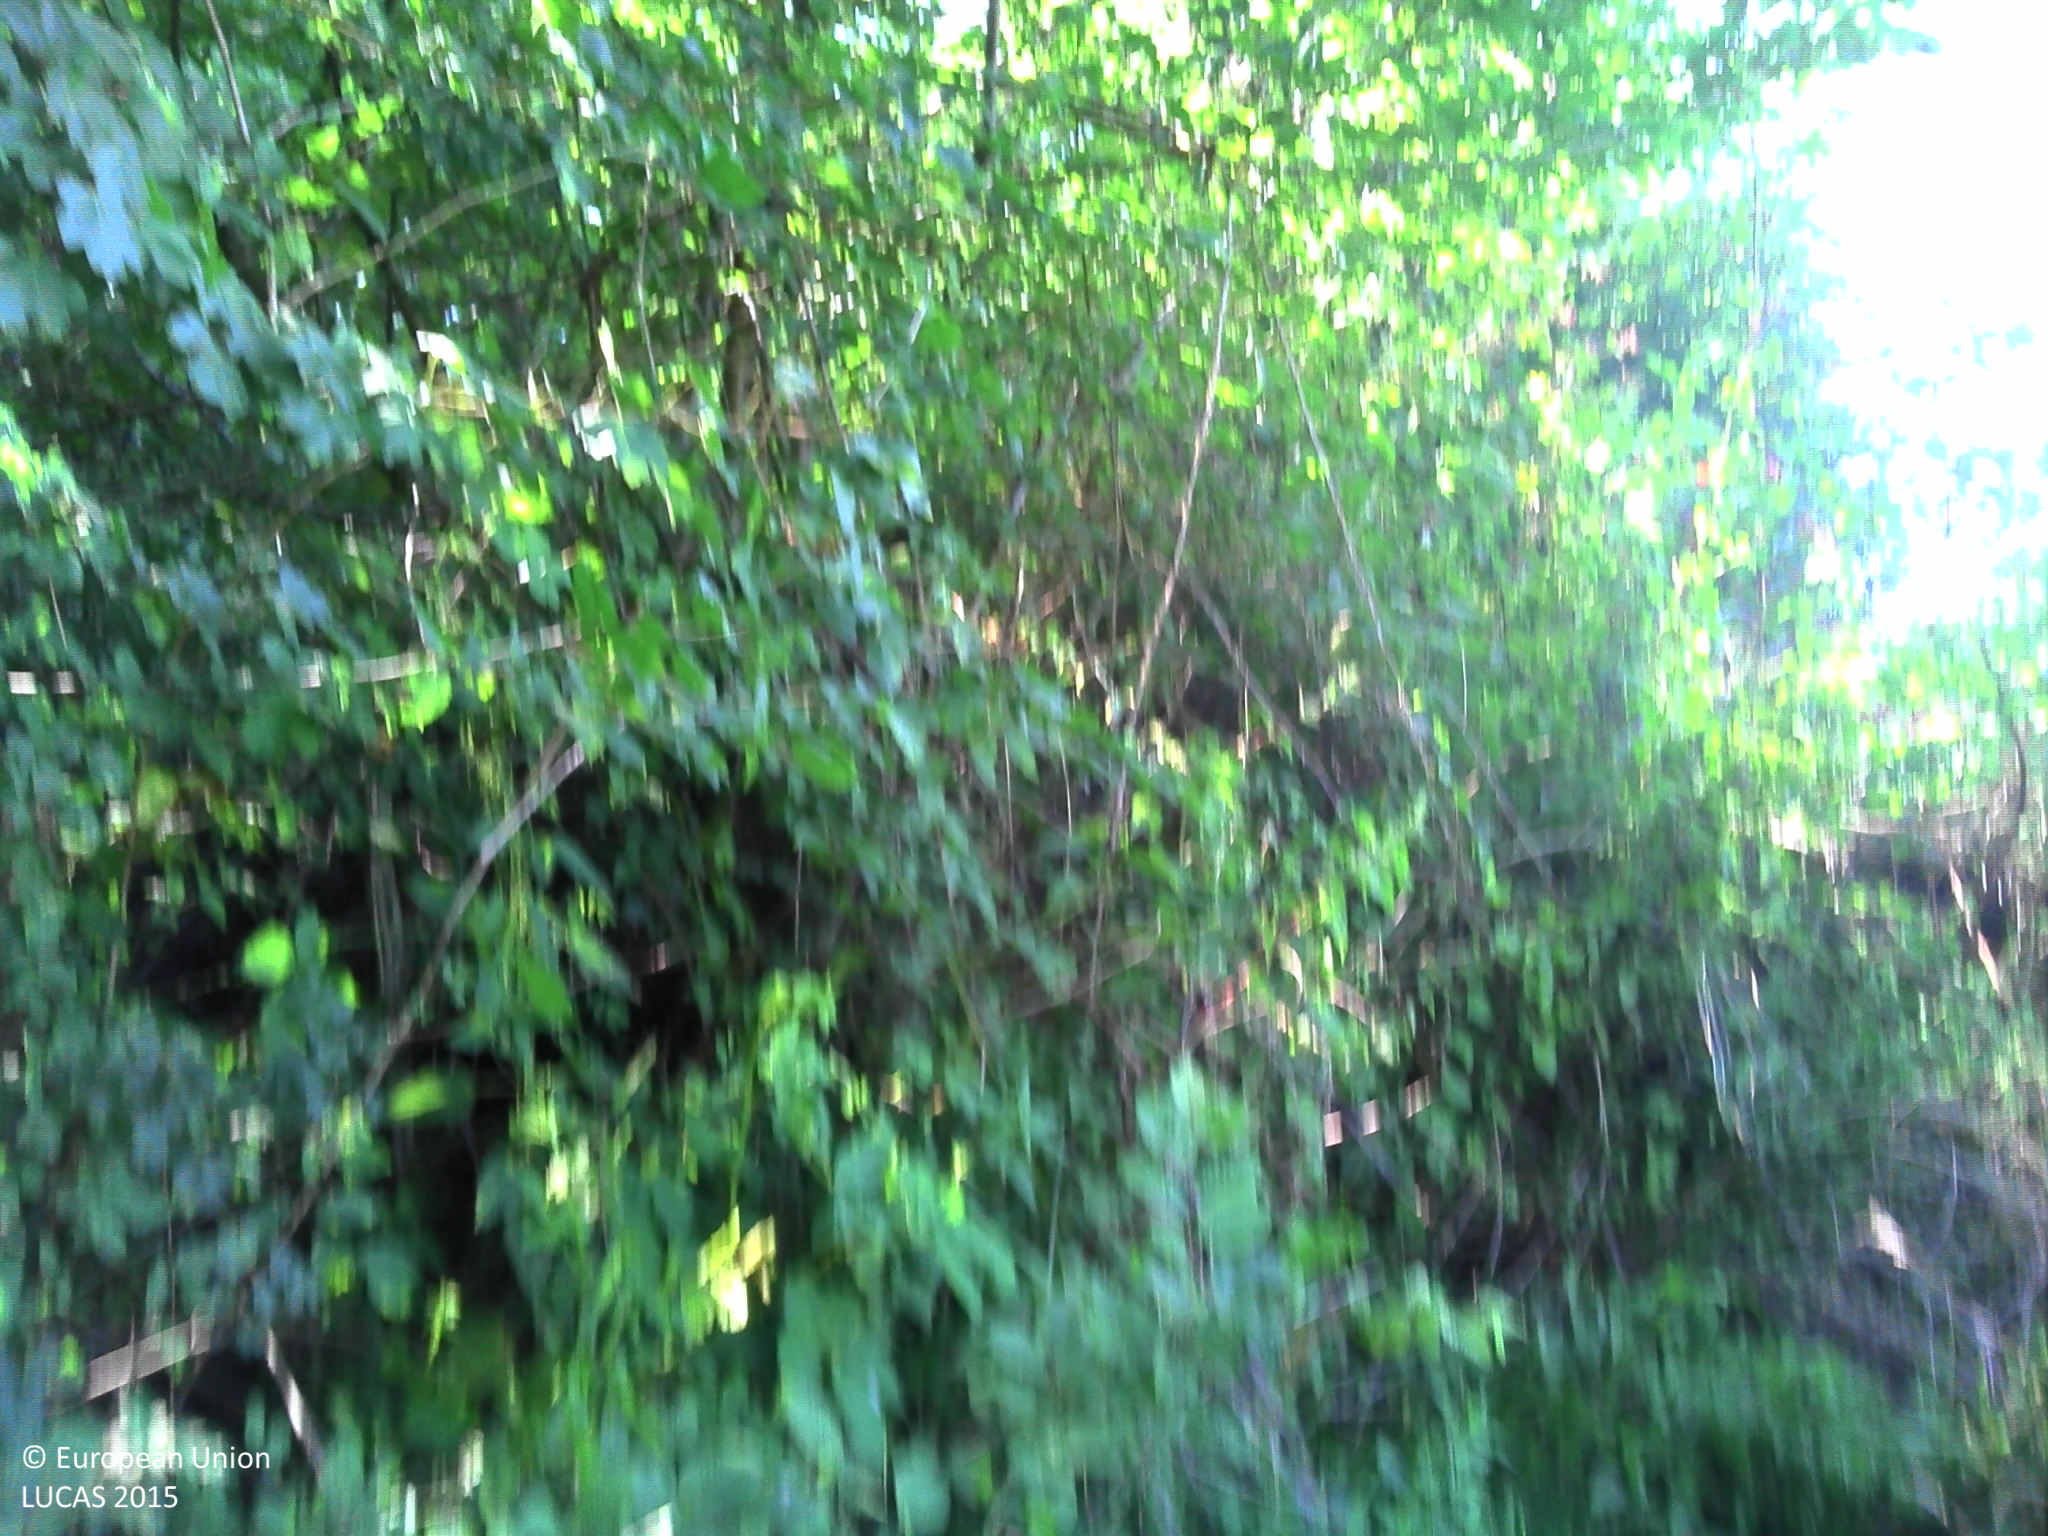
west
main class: Grassland
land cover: Grassland without tree/shrub cover
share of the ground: > 75 %
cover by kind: herbaceous plants 100 %
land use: Agriculture (excluding fallow land and kitchen gardens)
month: July
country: FR
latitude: 46.9511
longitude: 3.5464
